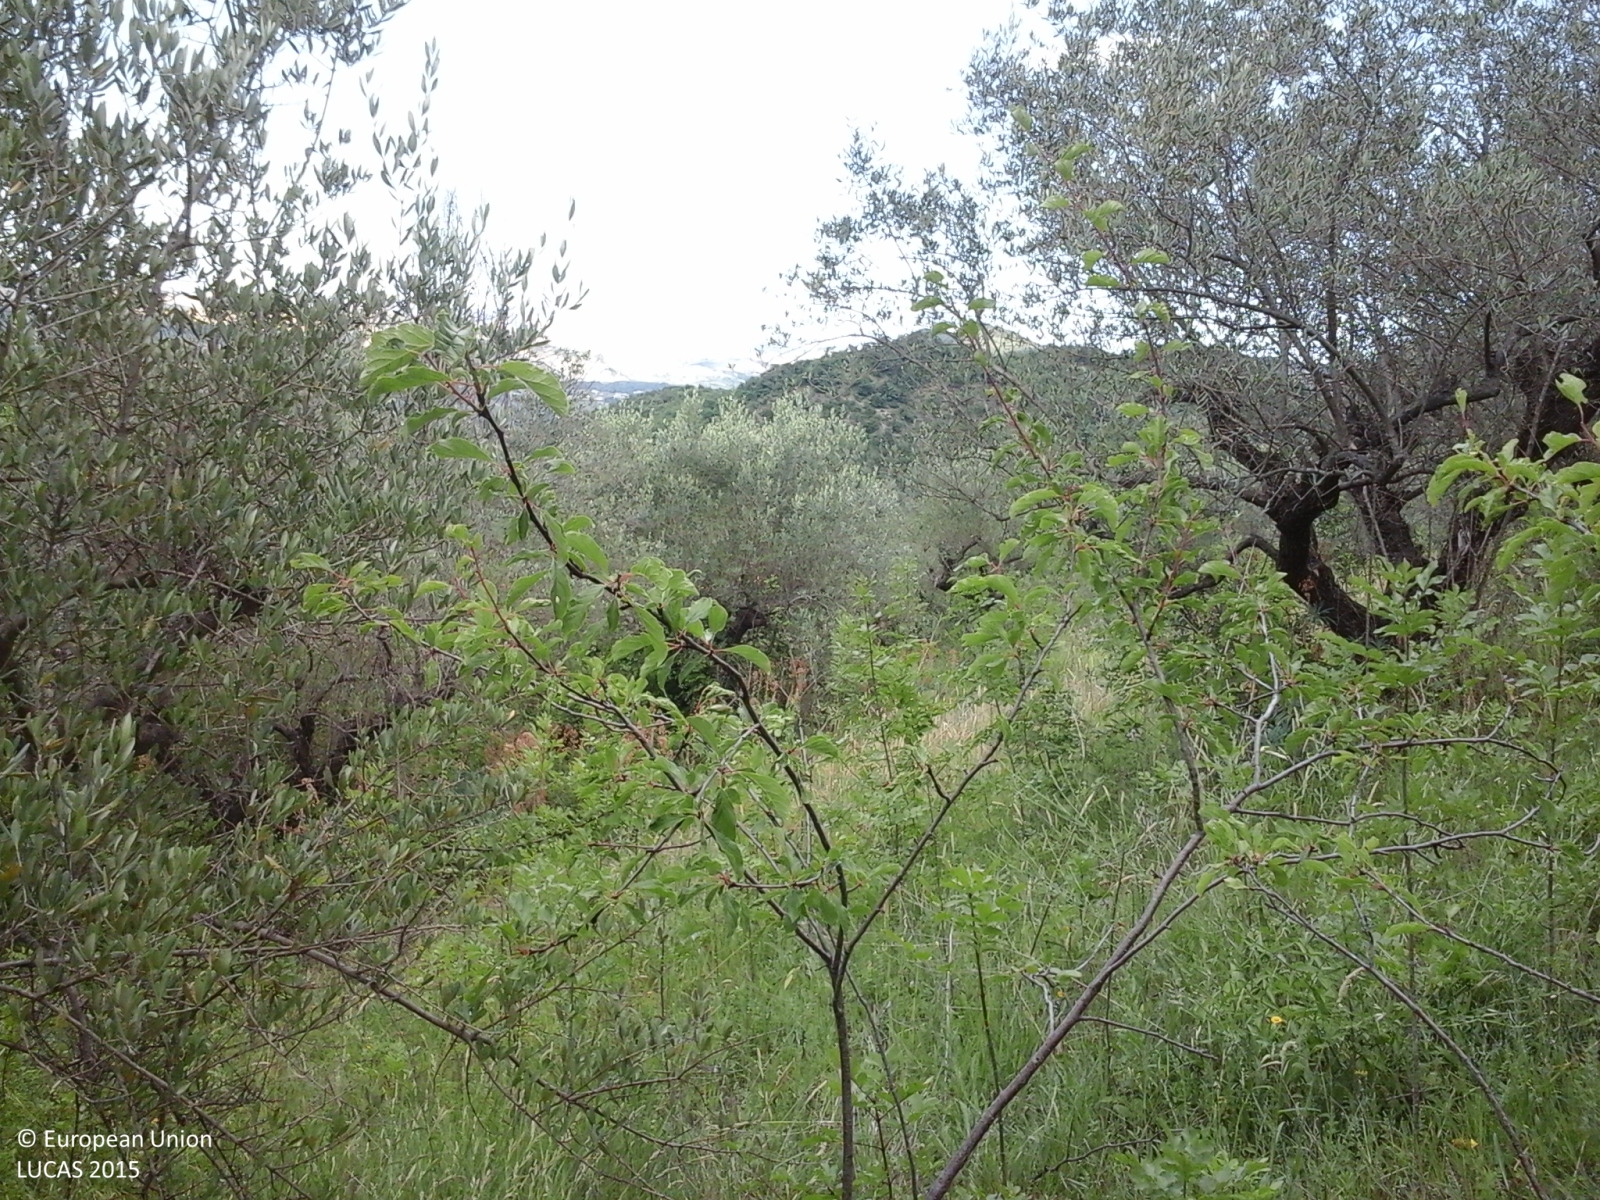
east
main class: Shrubland
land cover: Shrubland with sparse tree cover
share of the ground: > 75 %
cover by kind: shrubs 90 %, broadleaved forest trees 5 %, herbaceous plants 5 %
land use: Semi-natural and natural areas not in use
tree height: < 5 m
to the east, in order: Shrubland with sparse tree cover; Olive groves; Shrubland without tree cover; Olive groves; Shrubland with sparse tree cover; Tracks; Shrubland with sparse tree cover
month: June
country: IT
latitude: 42.0954
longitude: 14.2303
